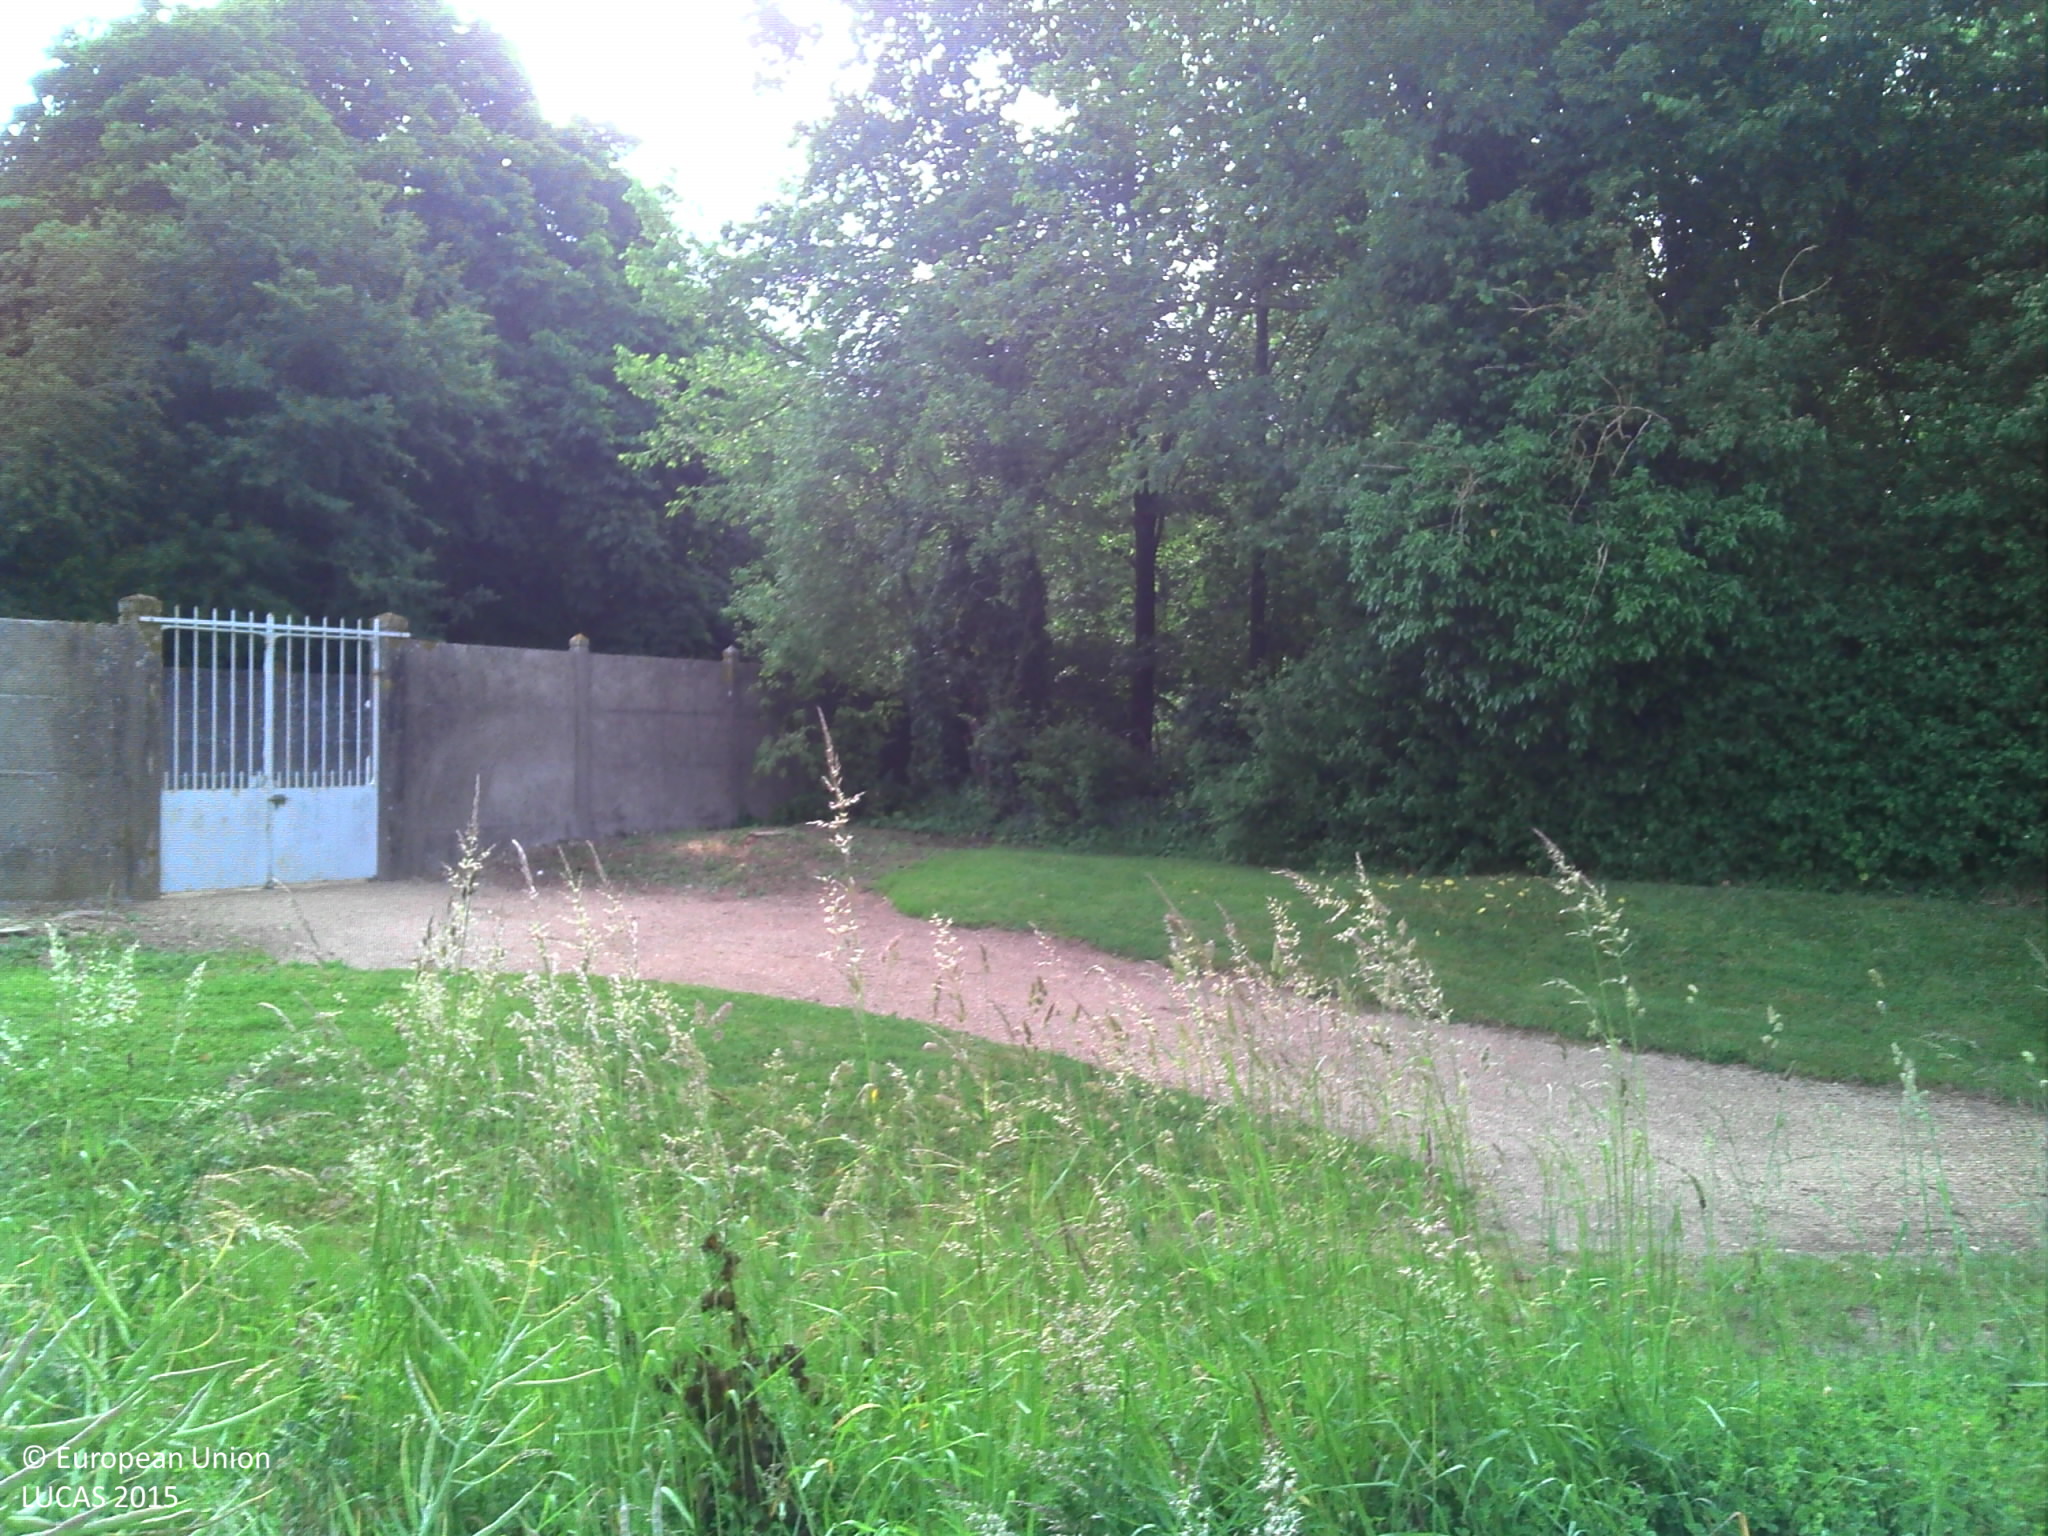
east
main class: Cropland
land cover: Rape and turnip rape
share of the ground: > 75 %
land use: Agriculture (excluding fallow land and kitchen gardens)
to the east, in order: Rape and turnip rape; Grassland without tree/shrub cover; Artificial constructions in urban areas; Broadleaved woodland; Grassland with sparse tree/shrub cover; Broadleaved woodland; Tracks; Broadleaved woodland; Ditches and canals; Grass margins; Paved roads, cycling and walking lanes; Grass margins; Ditches and canals; Fences; Grassland without tree/shrub cover
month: June
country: FR
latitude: 46.9336
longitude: 2.7047
